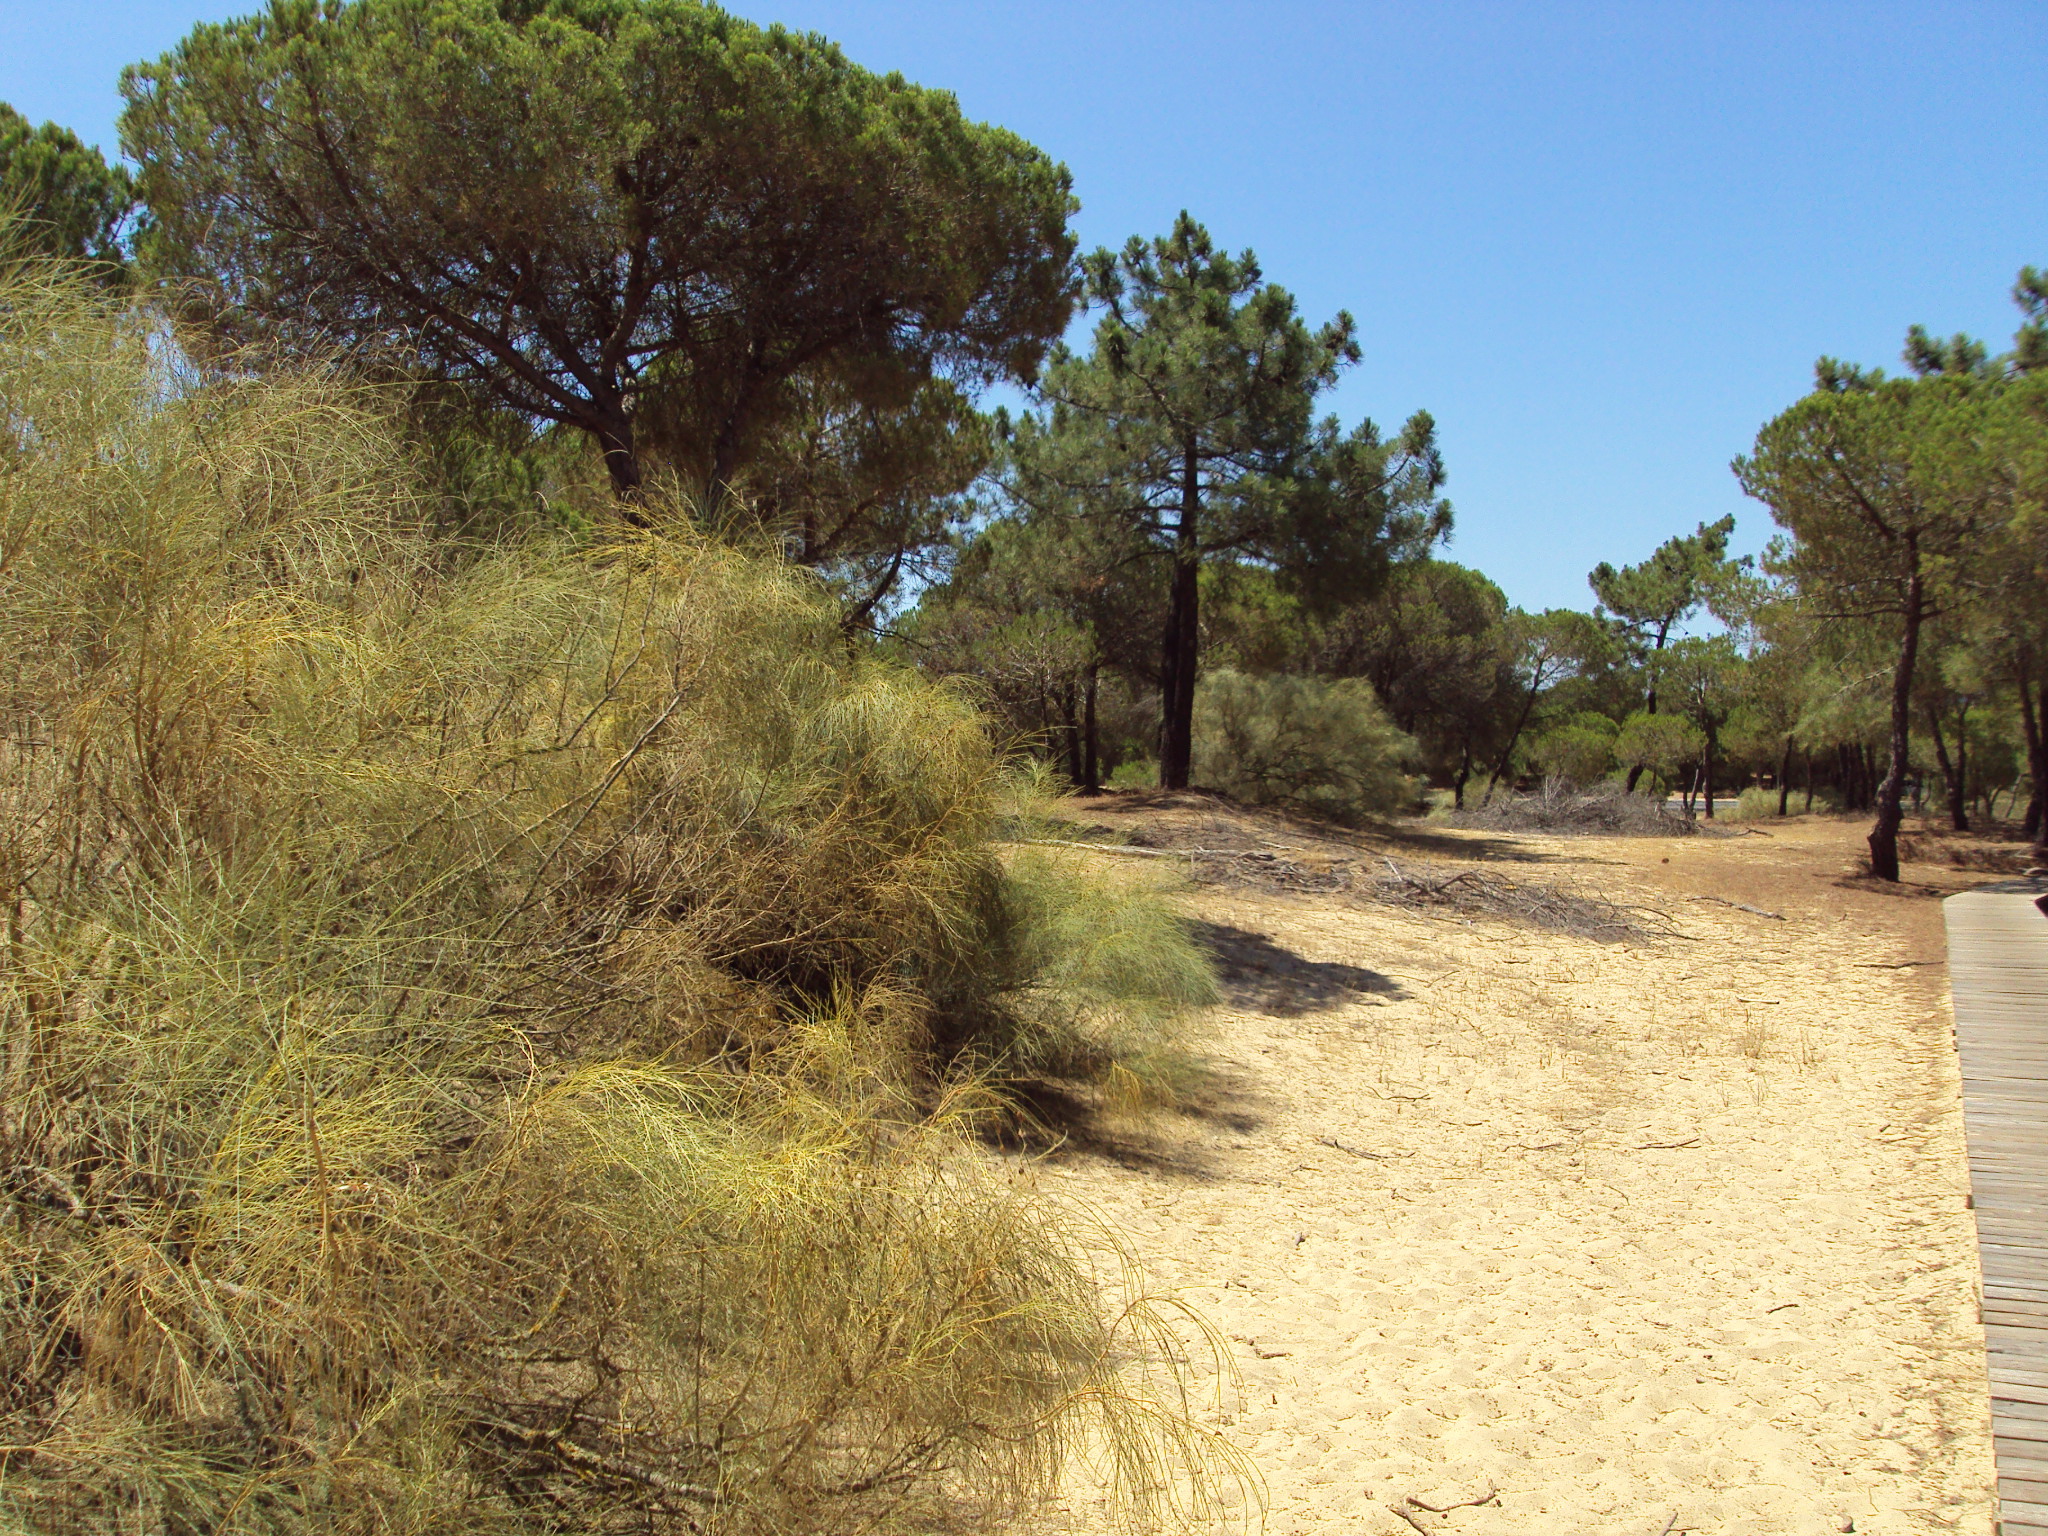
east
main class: Shrubland
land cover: Shrubland without tree cover
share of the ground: 50 - 75 %
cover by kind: shrubs 60 %, herbaceous plants 20 %, unconsolidated bare surface 20 %
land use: Semi-natural and natural areas not in use
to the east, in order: Shrubland without tree cover; Inland marshes; Pine dominated coniferous woodland; Fences; Pine dominated coniferous woodland
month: July
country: ES
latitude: 37.2130
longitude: -7.0434
